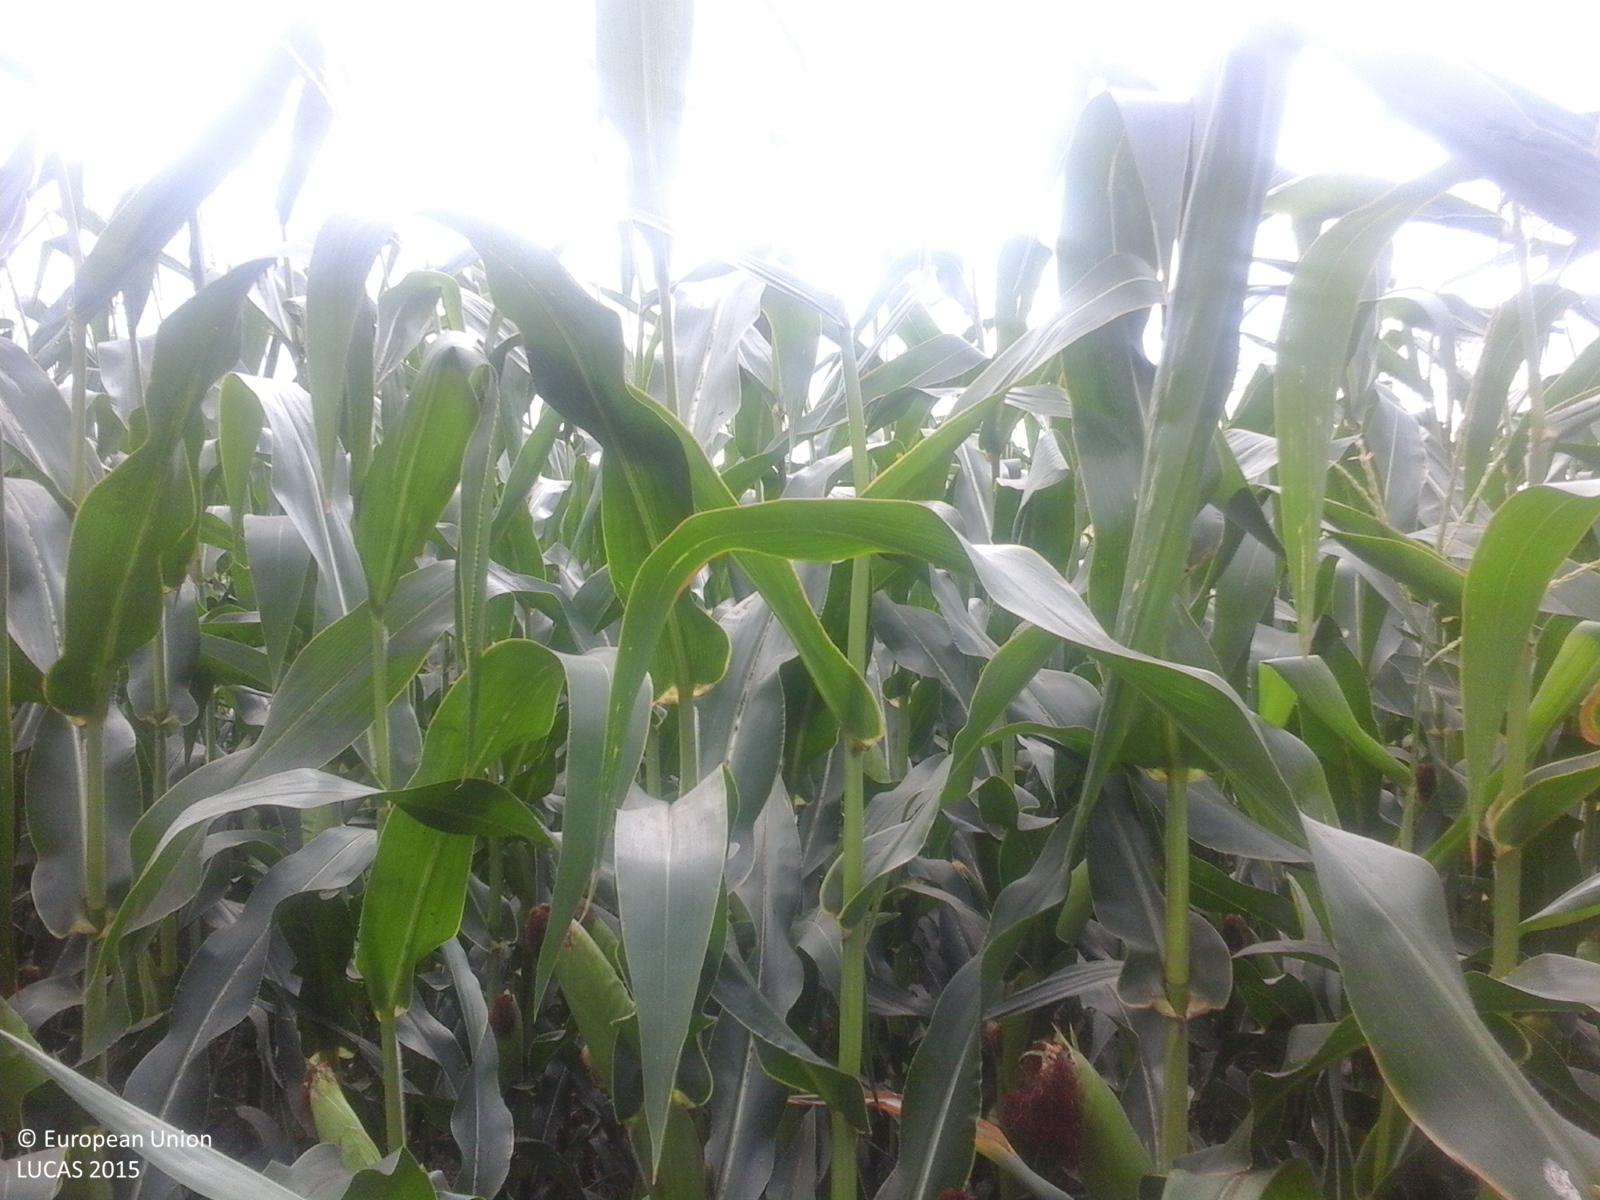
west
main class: Cropland
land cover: Maize
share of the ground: > 75 %
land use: Agriculture (excluding fallow land and kitchen gardens)
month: August
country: RO
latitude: 44.6289
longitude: 28.2813
